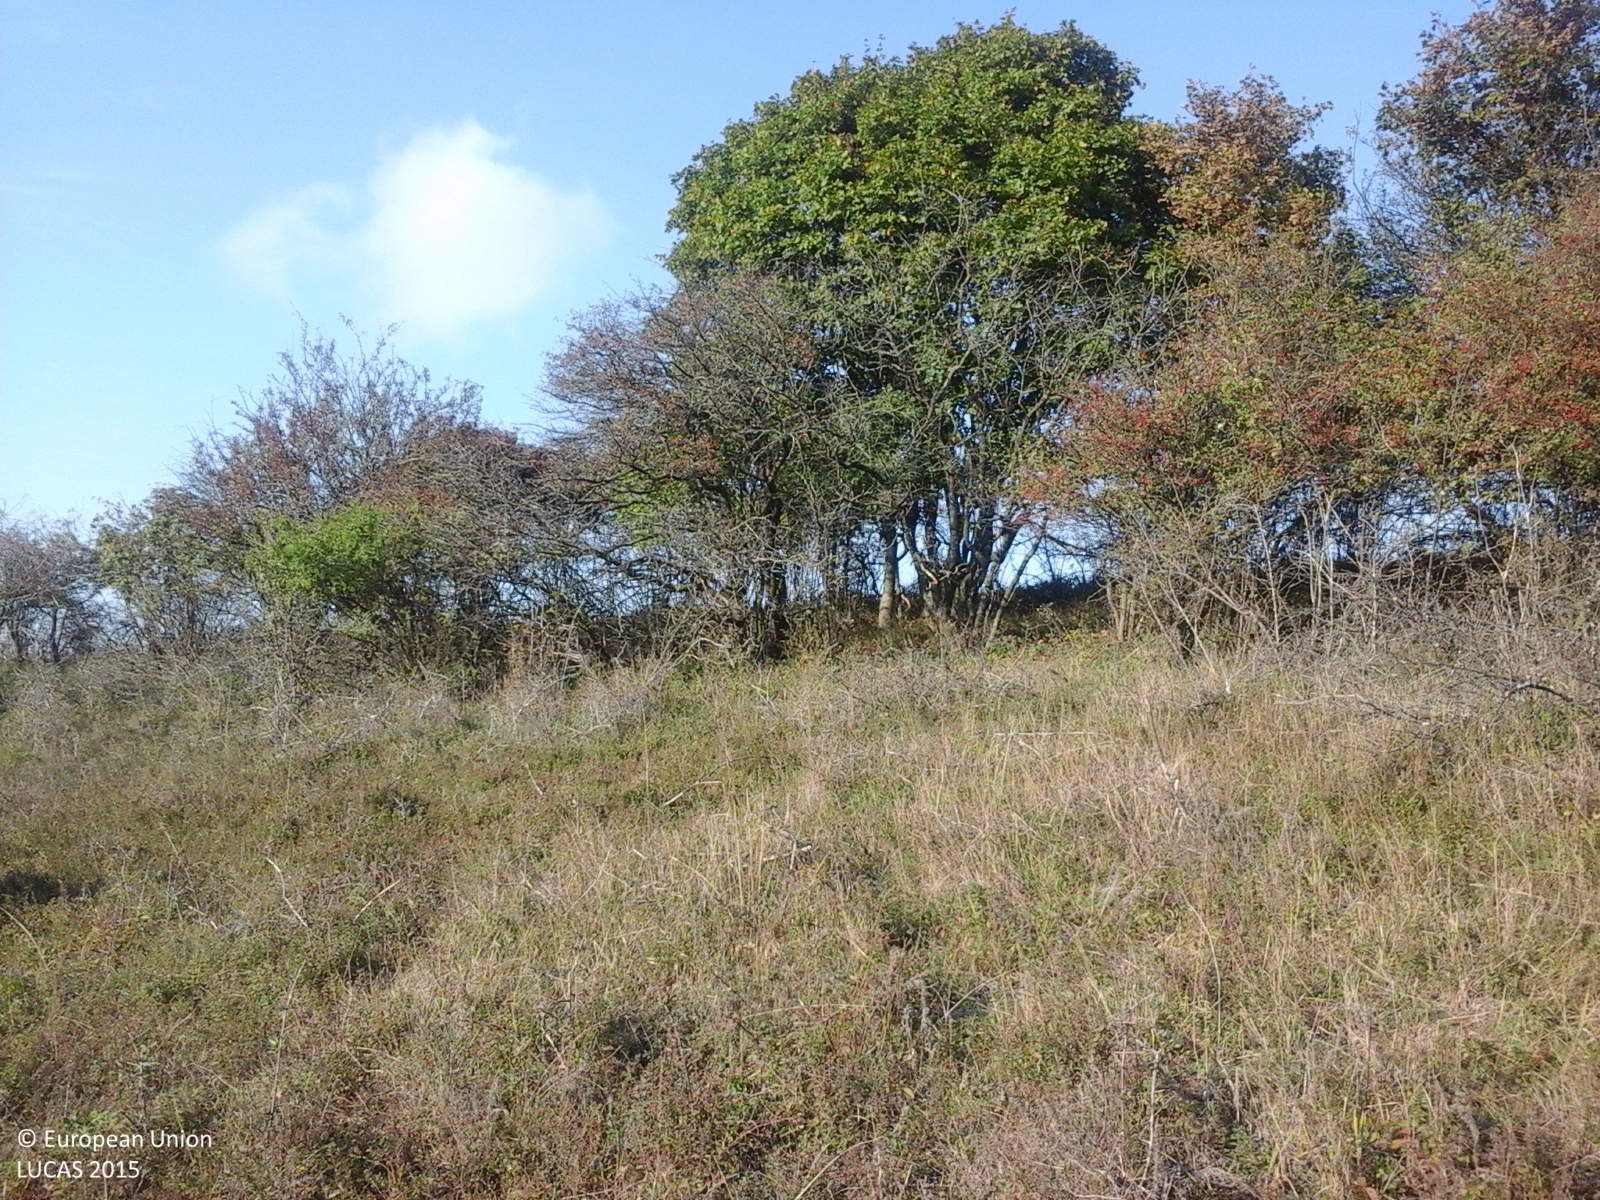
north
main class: Grassland
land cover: Grassland with sparse tree/shrub cover
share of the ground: > 75 %
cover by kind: herbaceous plants 95 %, broadleaved forest trees 5 %
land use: Agriculture (excluding fallow land and kitchen gardens)
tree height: < 5 m
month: October
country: RO
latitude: 46.3614
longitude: 24.1020
